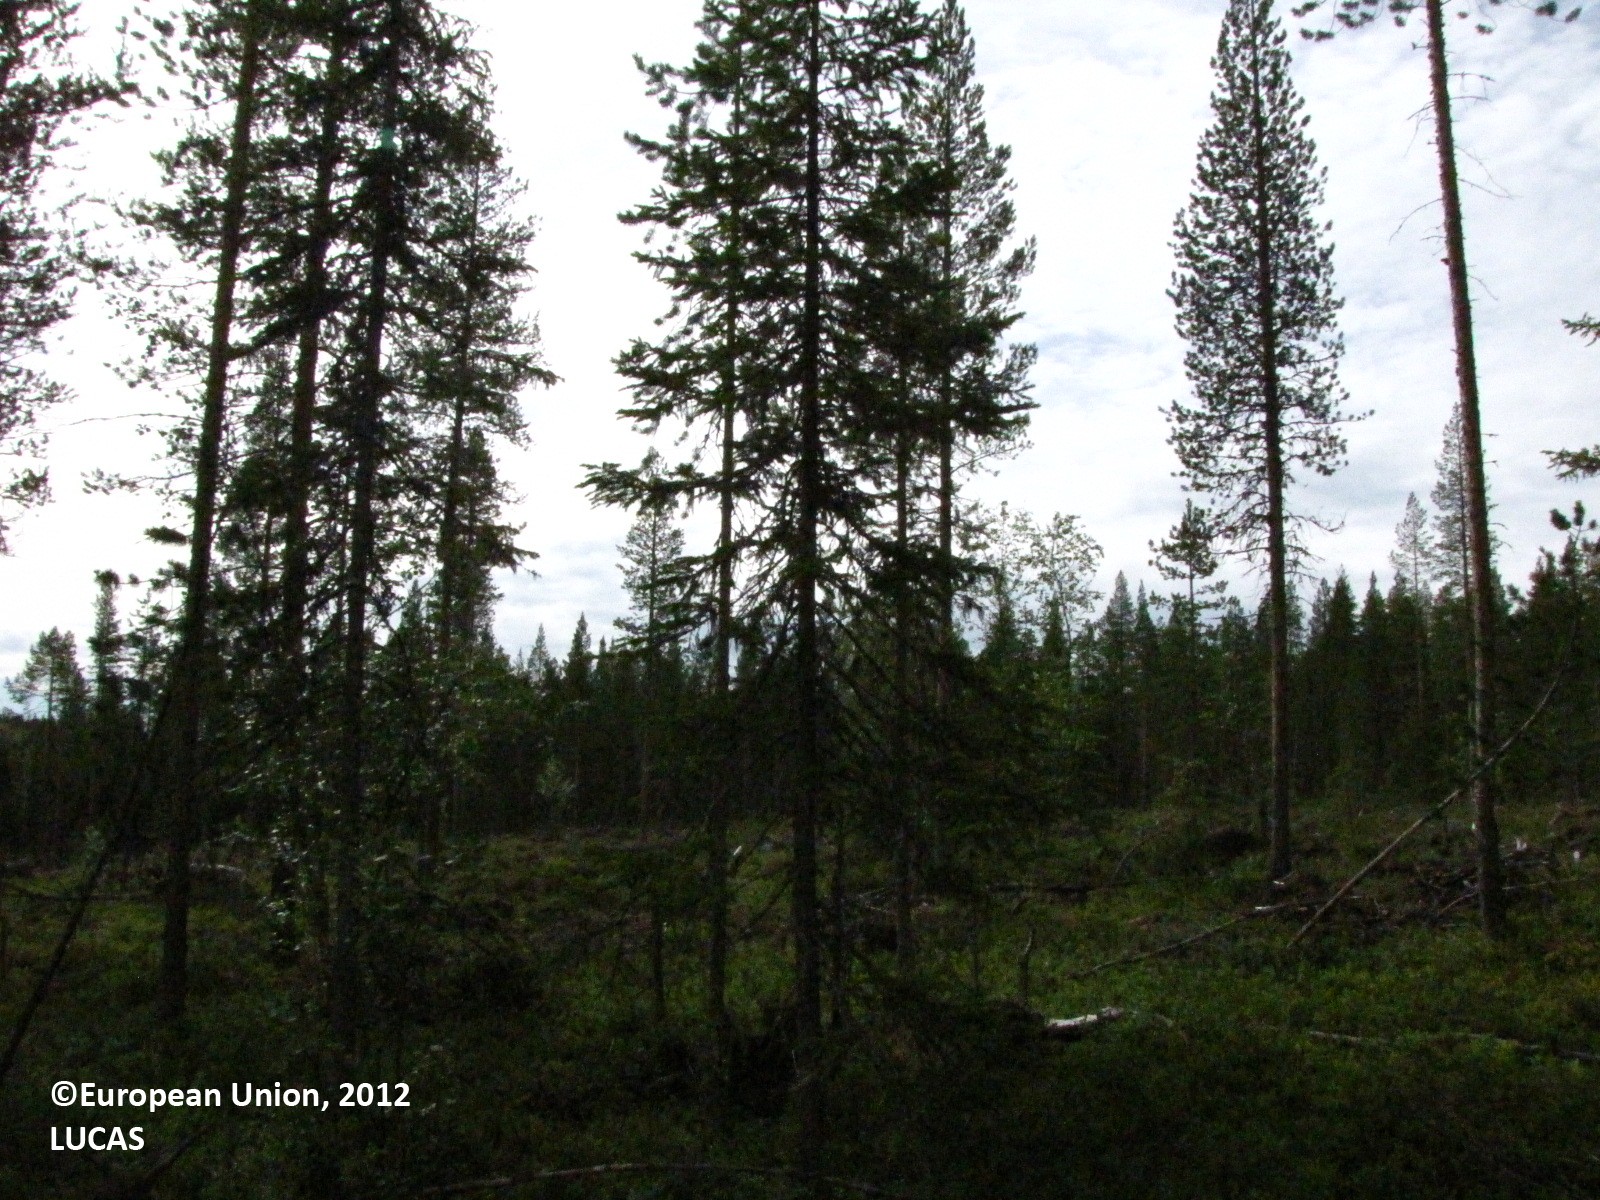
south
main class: Woodland
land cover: Other coniferous woodland
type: boreal forest
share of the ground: 50 - 75 %
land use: Forestry
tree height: > 5 m
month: July
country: FI
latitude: 66.7044
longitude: 25.0759
